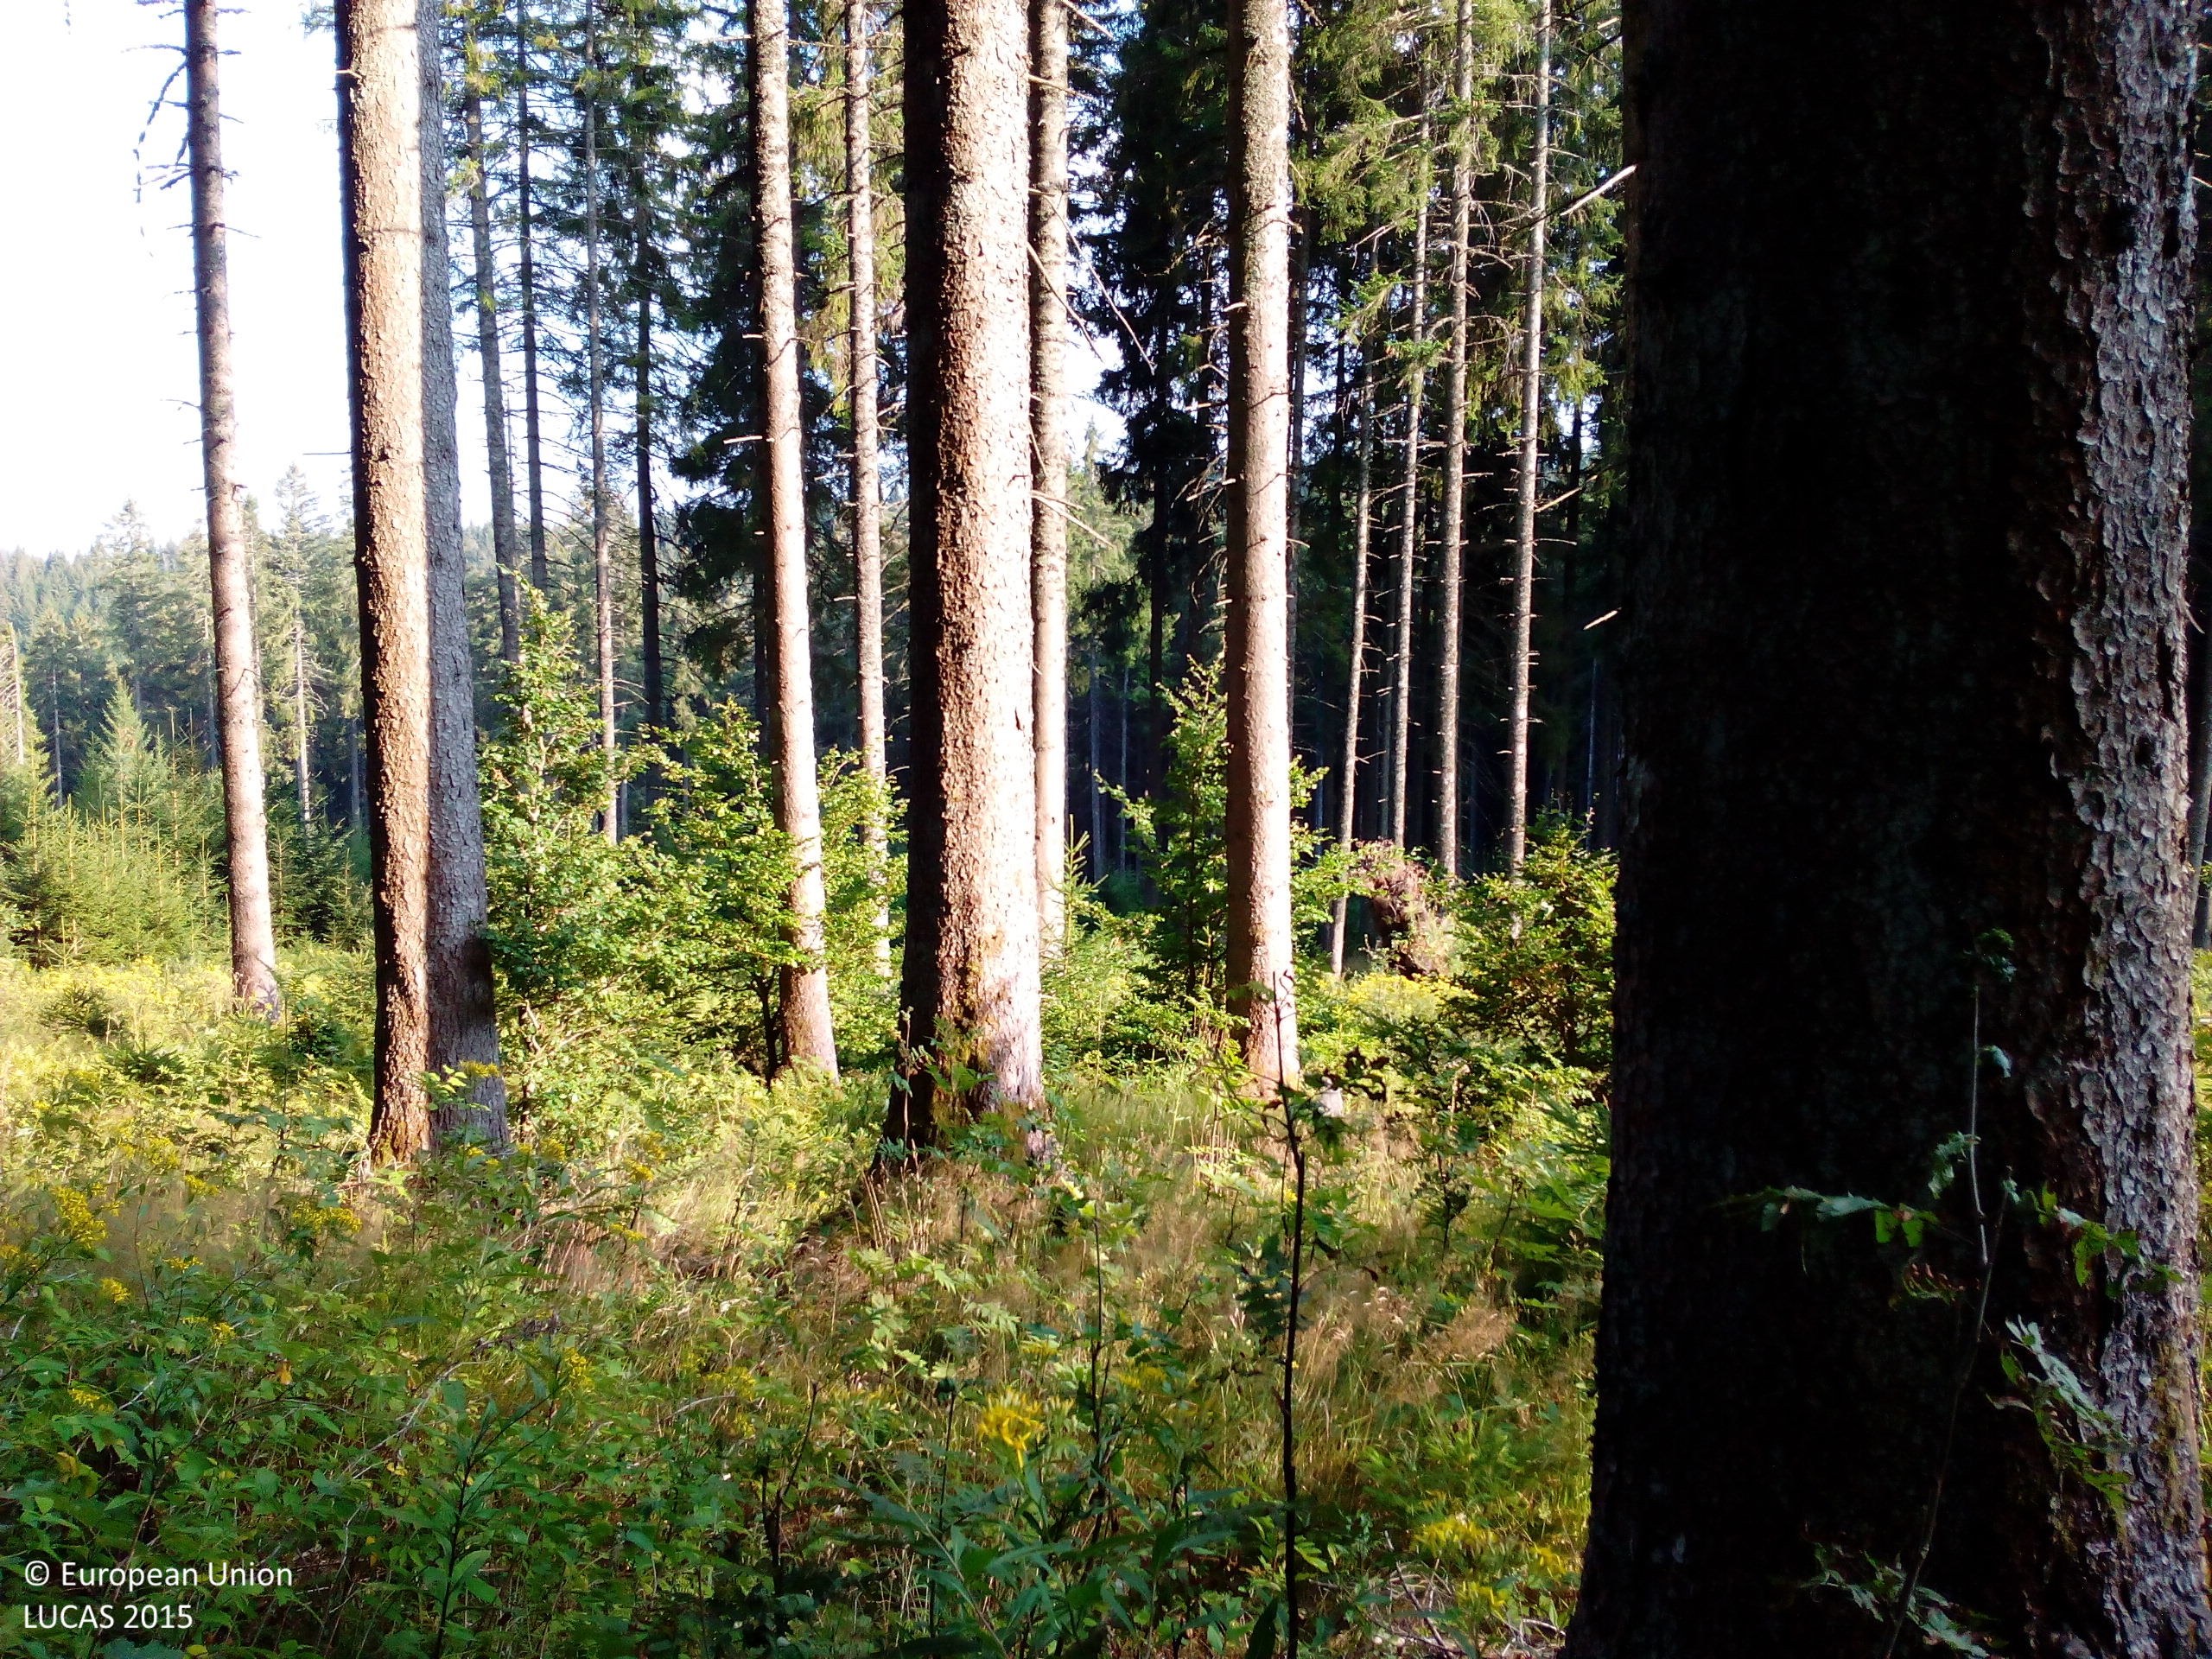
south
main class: Woodland
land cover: Spruce dominated coniferous woodland
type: hemiboreal forest and nemoral coniferous forest and mixed broadleaved-coniferous forest
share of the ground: 50 - 75 %
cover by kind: coniferous forest trees 60 %, shrubs 20 %, herbaceous plants 20 %
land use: Forestry
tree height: > 5 m
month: August
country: DE
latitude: 47.8475
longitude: 8.1170
